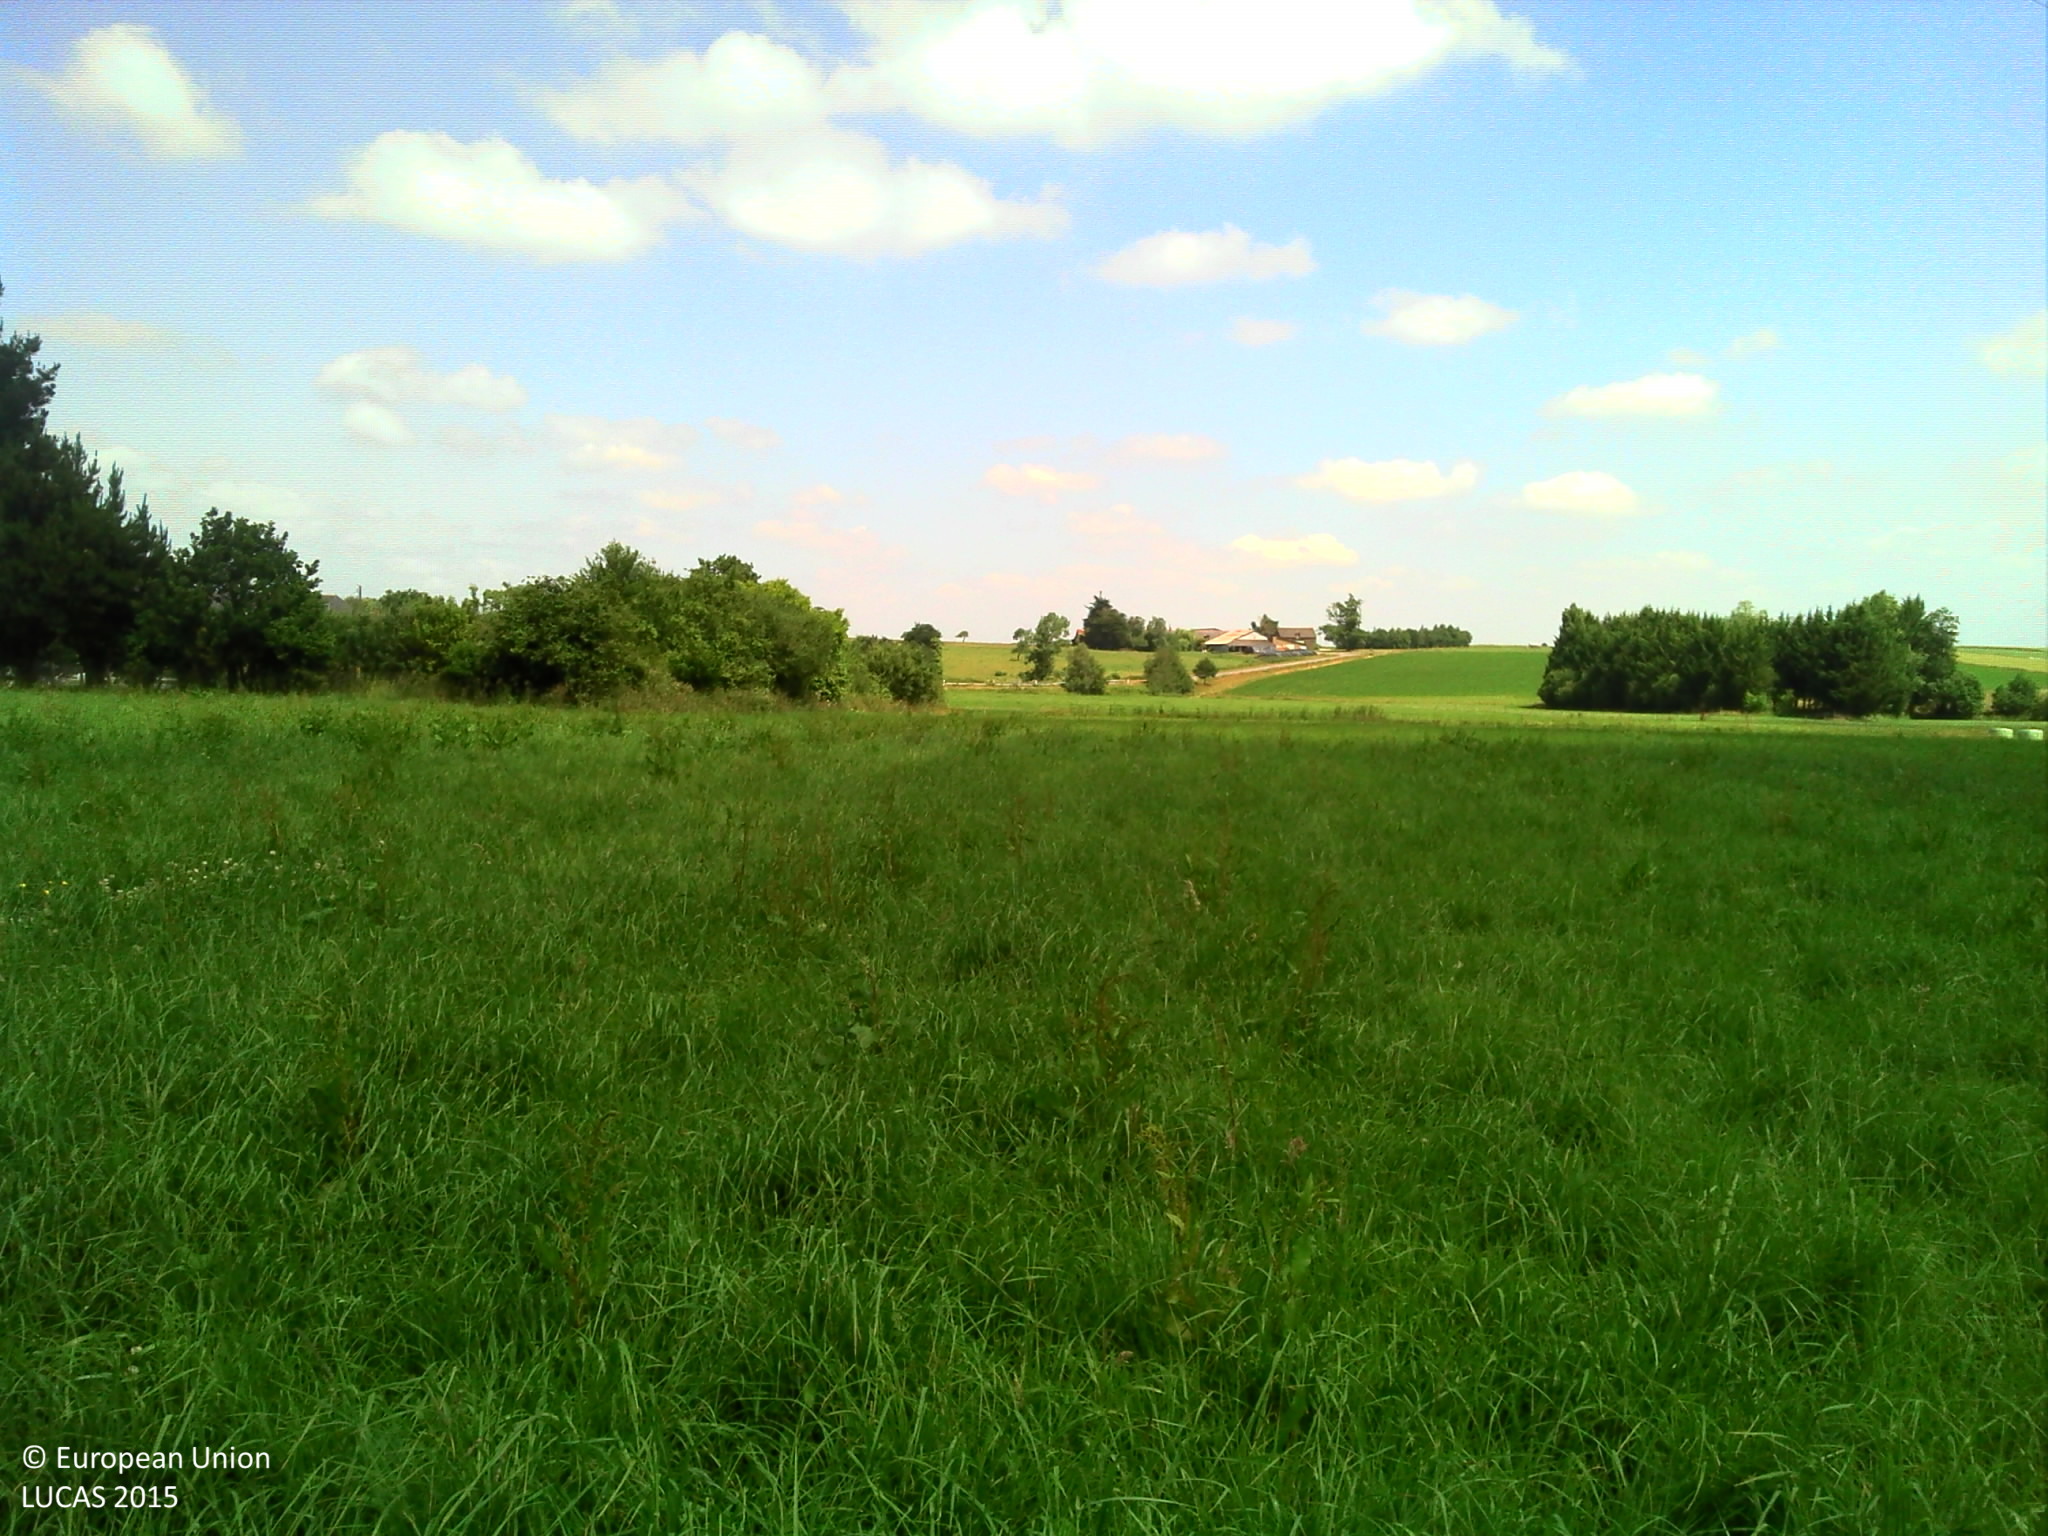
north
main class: Grassland
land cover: Grassland without tree/shrub cover
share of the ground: > 75 %
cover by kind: herbaceous plants 100 %
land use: Agriculture (excluding fallow land and kitchen gardens)
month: June
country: FR
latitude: 48.0318
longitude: -1.8924
